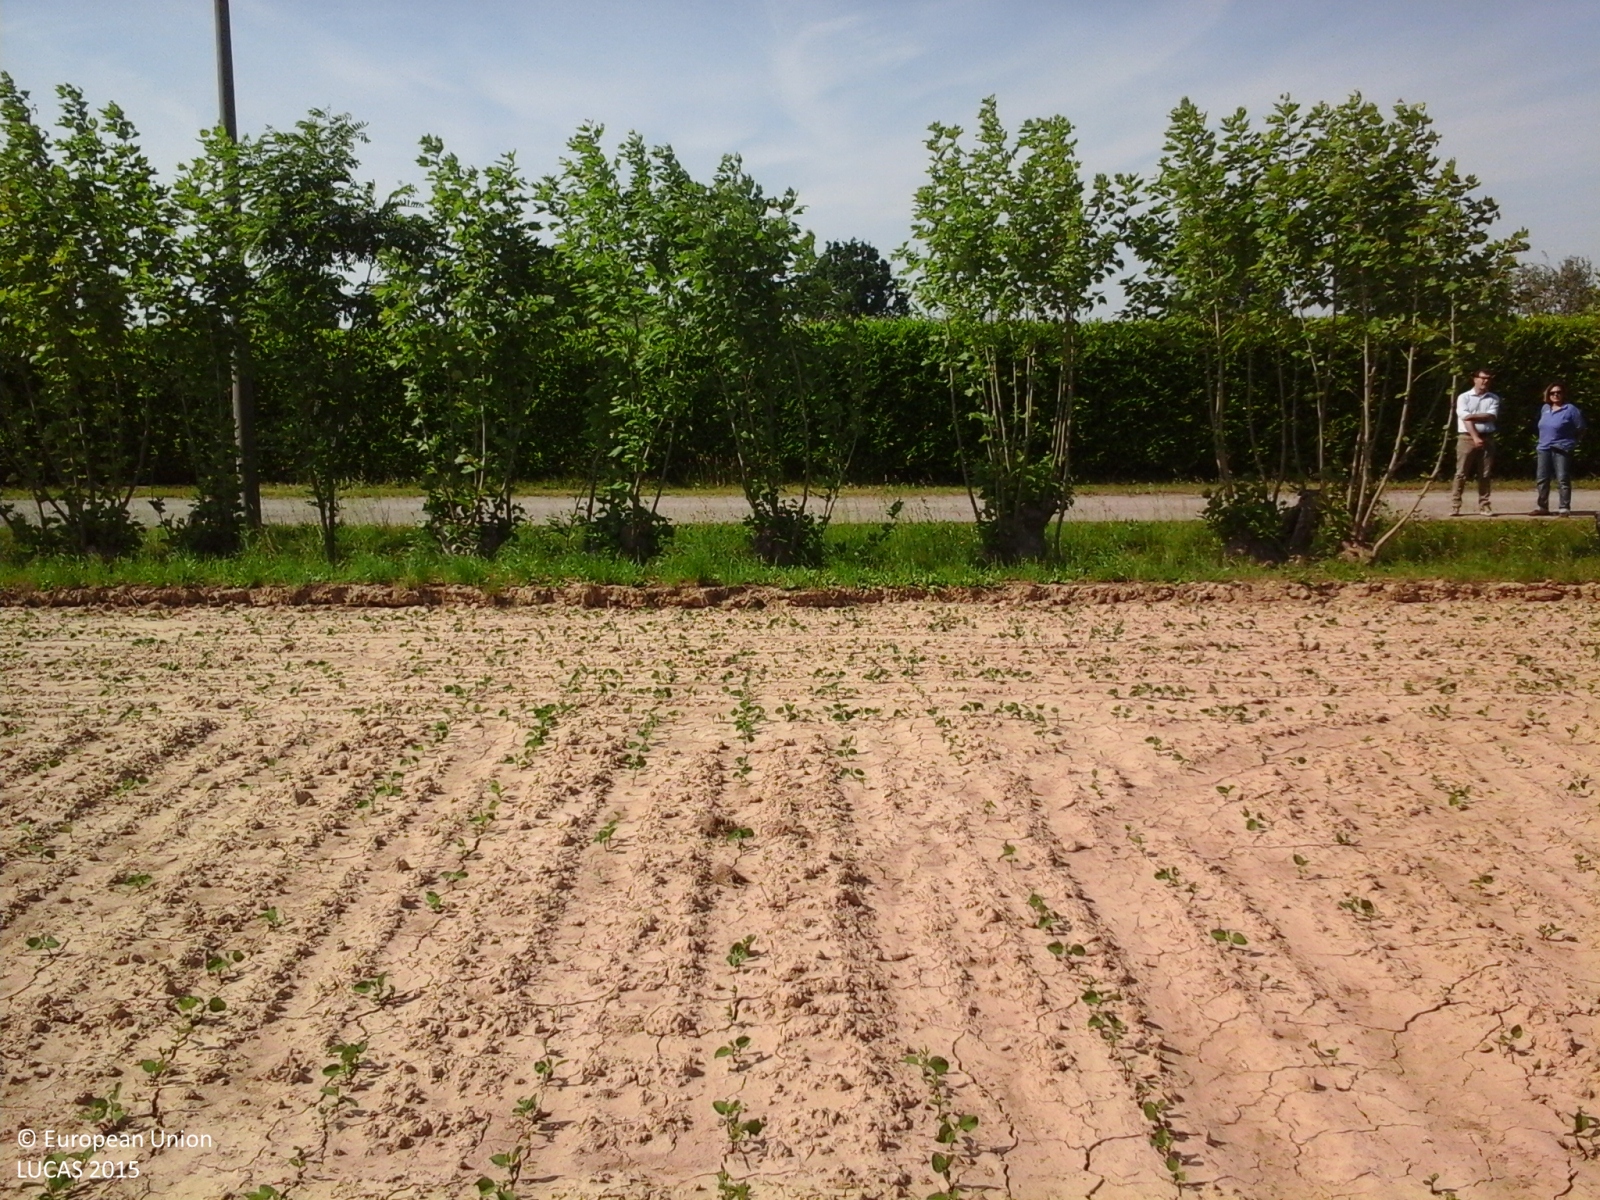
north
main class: Cropland
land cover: Soya
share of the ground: < 10 %
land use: Agriculture (excluding fallow land and kitchen gardens)
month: May
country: IT
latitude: 45.3818
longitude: 11.7467
